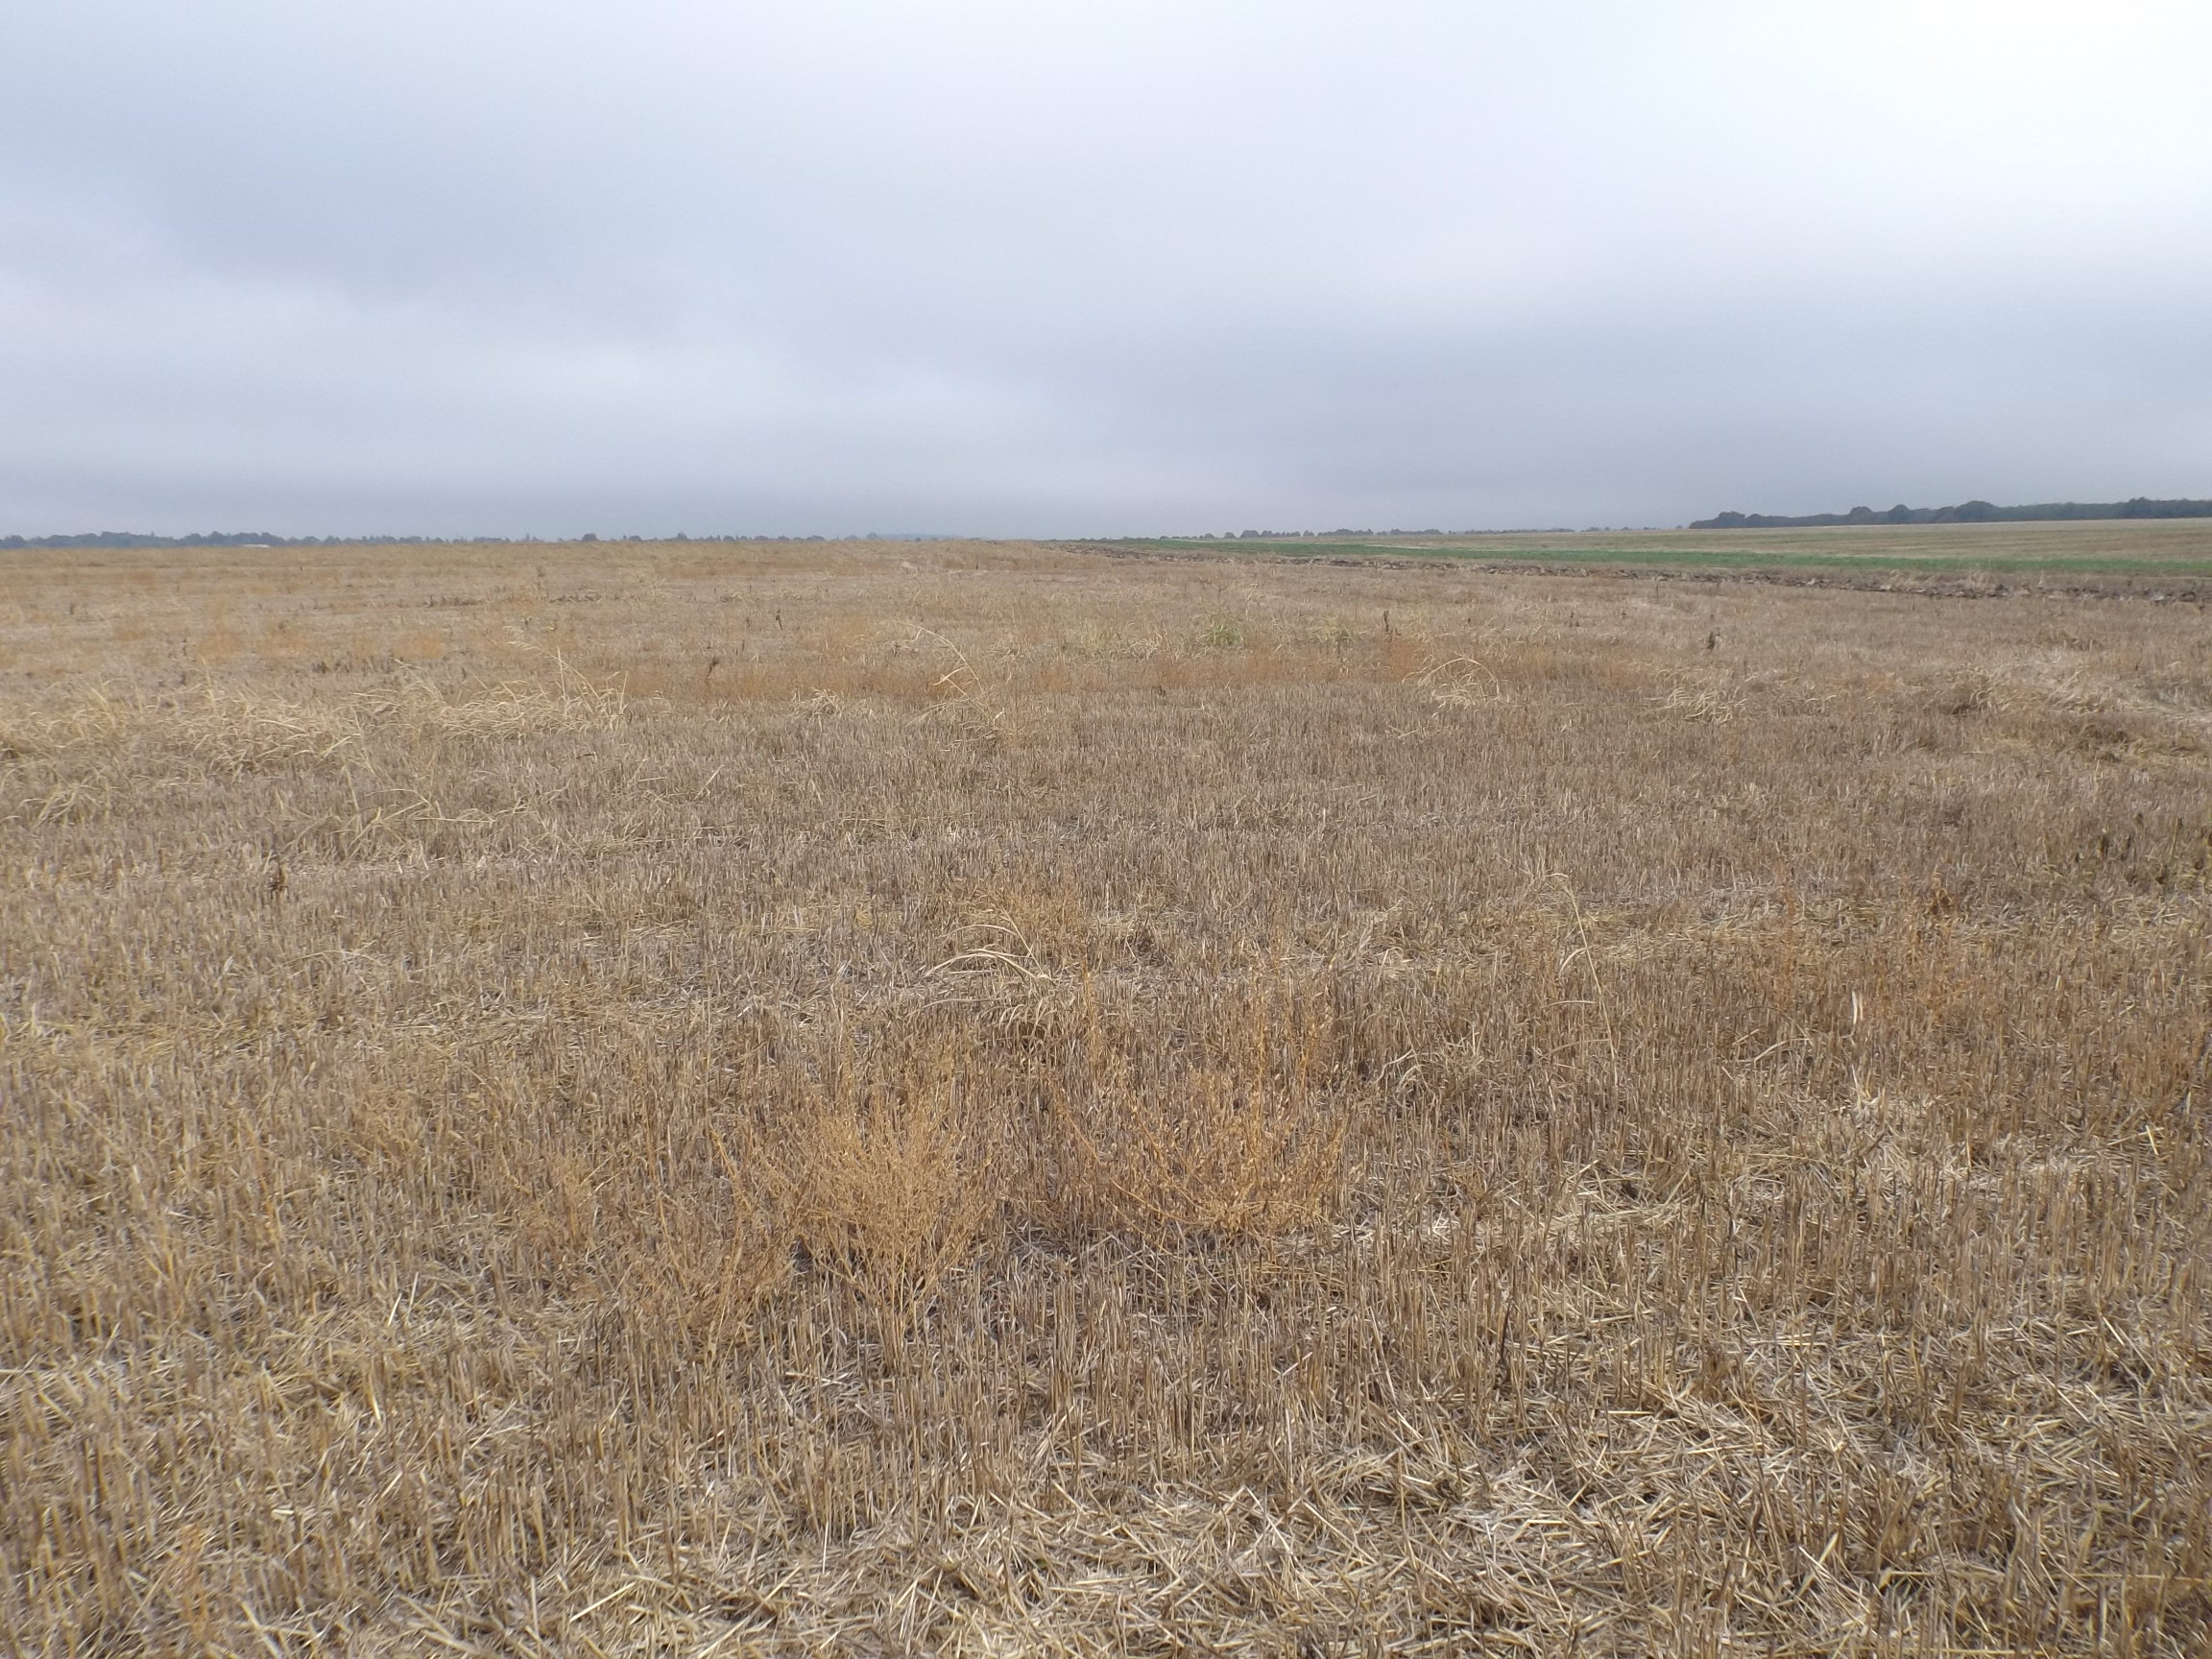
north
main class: Cropland
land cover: Oats
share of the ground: 50 - 75 %
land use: Agriculture (excluding fallow land and kitchen gardens)
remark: Harvested field
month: September
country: BG
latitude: 43.9762
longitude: 26.3749
